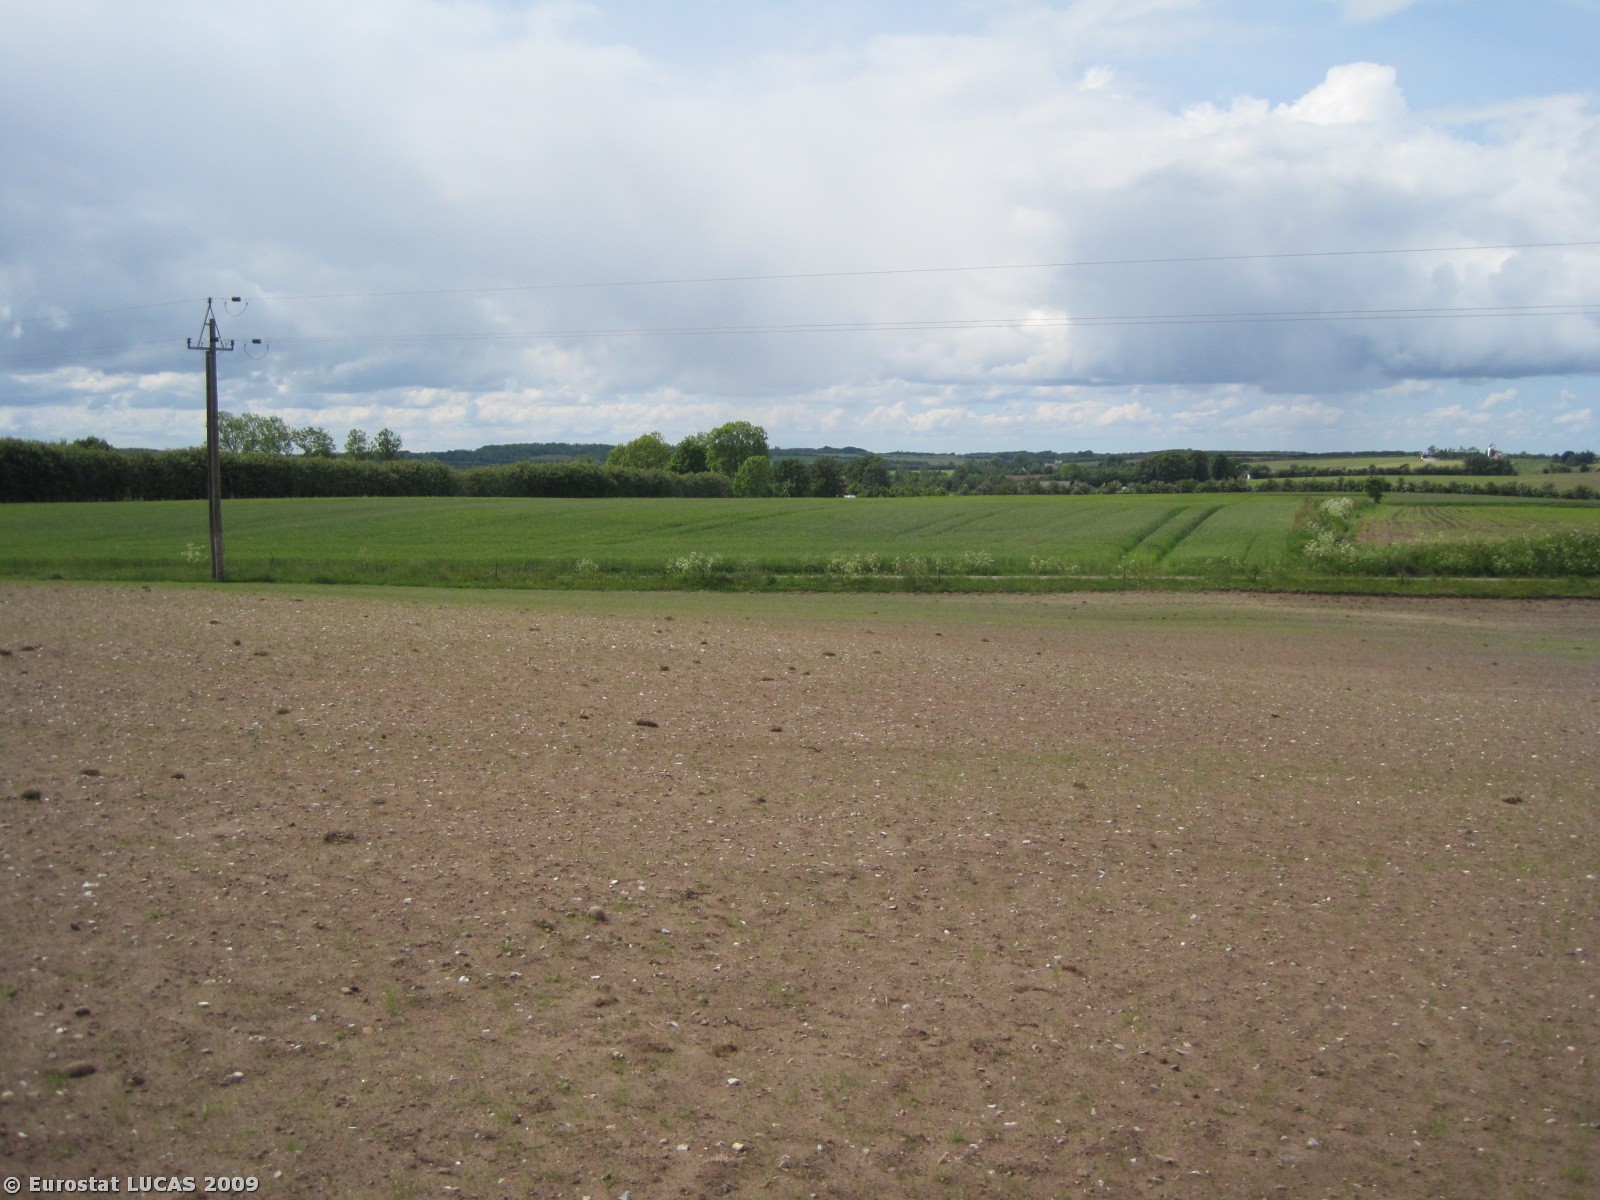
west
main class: Cropland
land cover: Common wheat
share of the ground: < 10 %
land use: Agriculture (excluding fallow land and kitchen gardens)
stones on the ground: 10 - 25 %
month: June
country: DK
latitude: 56.8885
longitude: 9.6886
